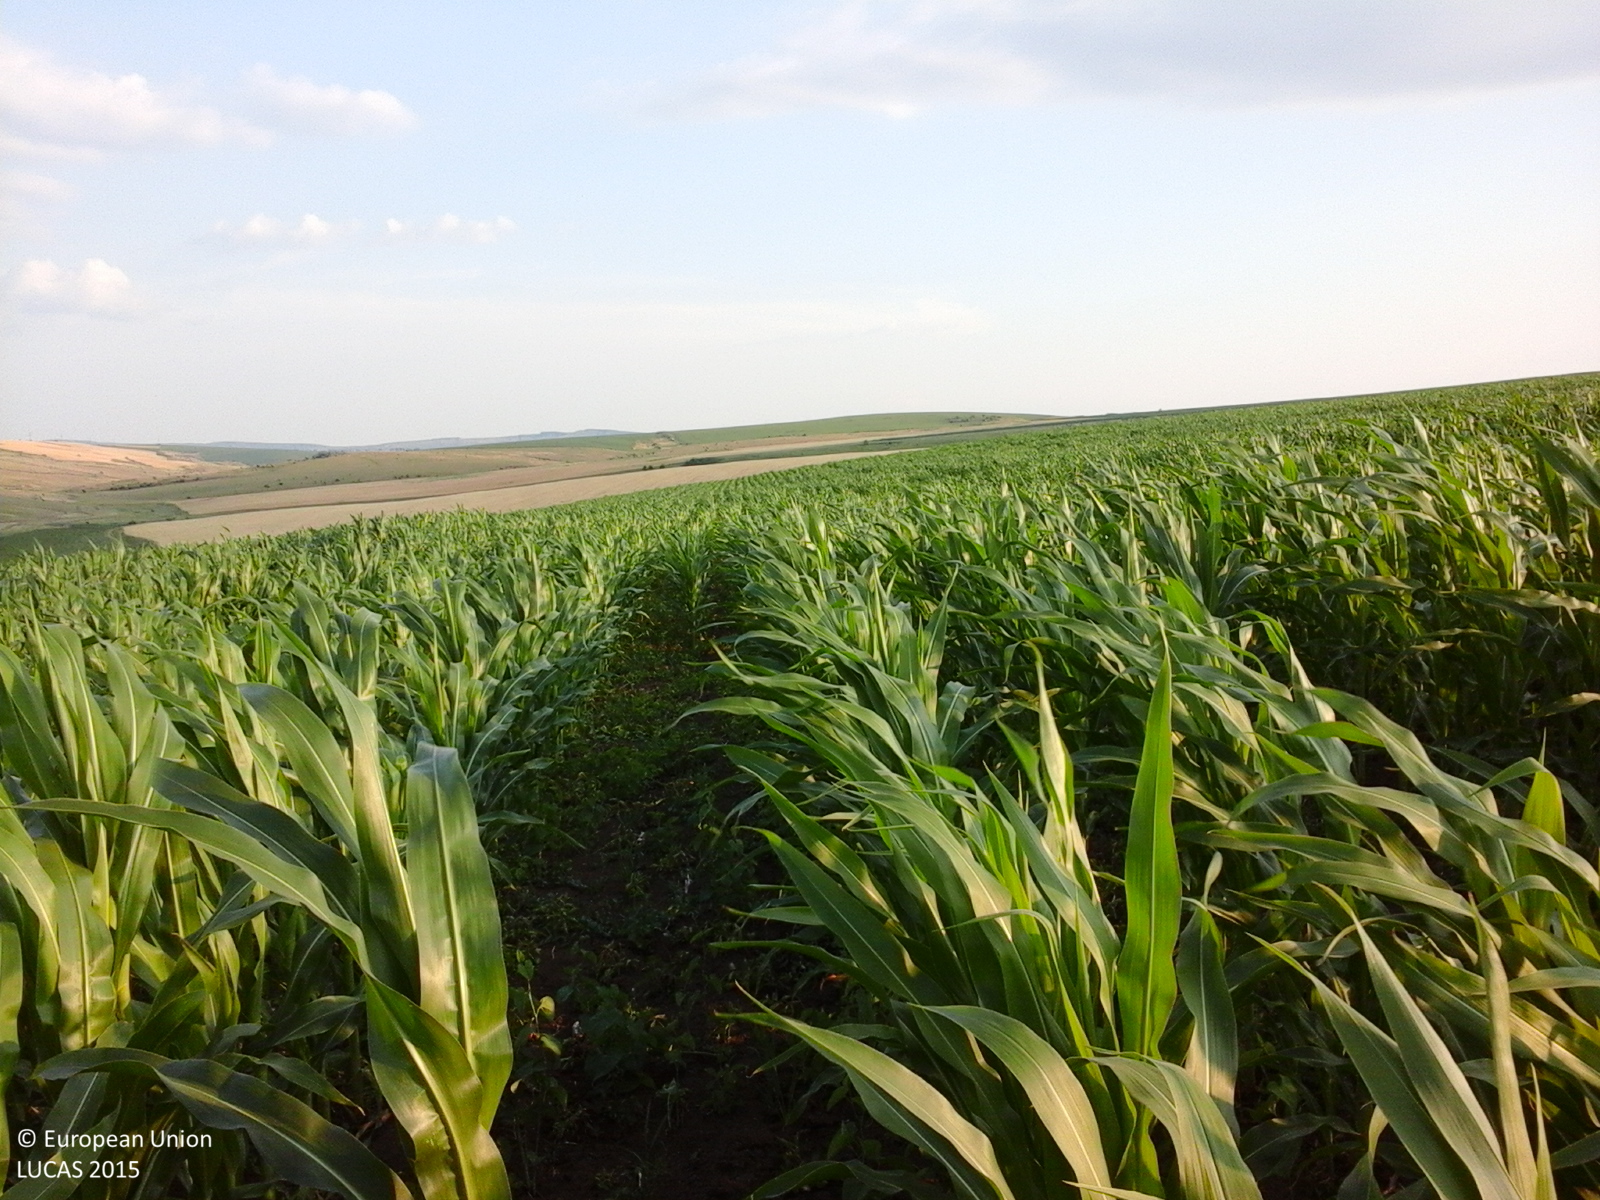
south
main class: Cropland
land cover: Maize
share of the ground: > 75 %
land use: Agriculture (excluding fallow land and kitchen gardens)
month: June
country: RO
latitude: 47.1692
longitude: 27.4360
